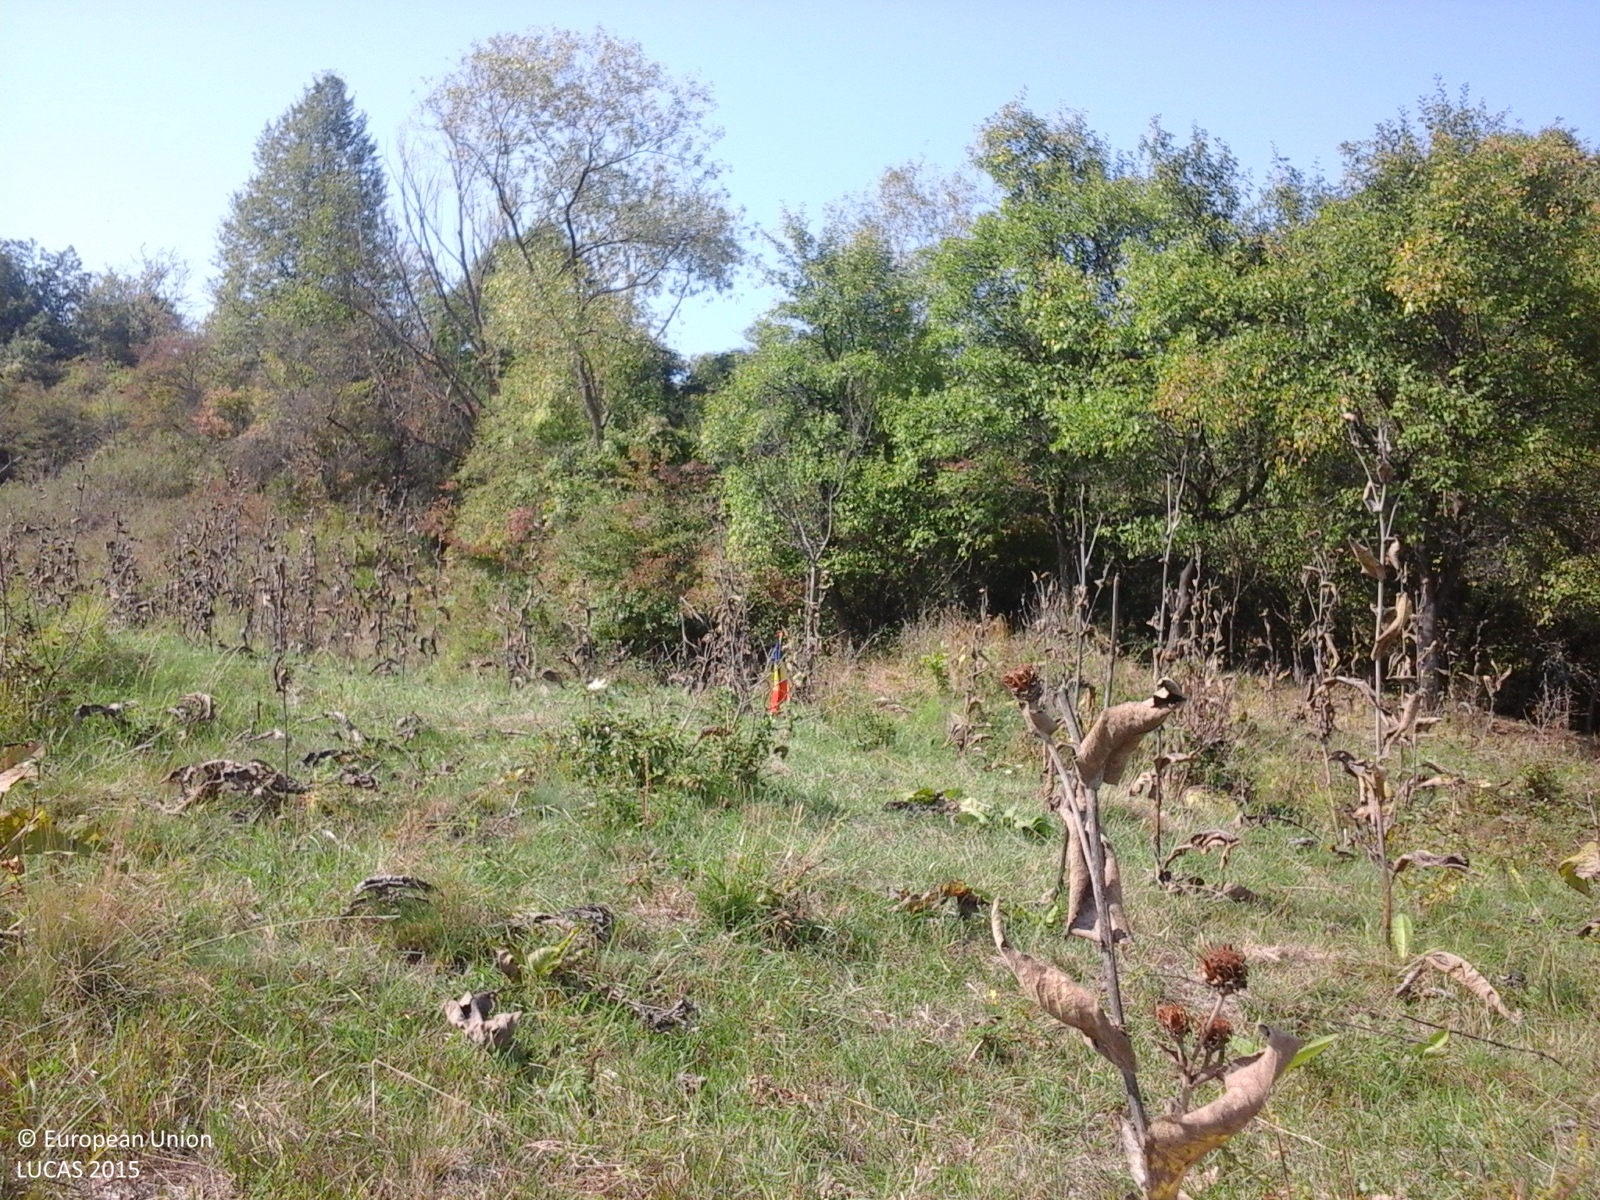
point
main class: Grassland
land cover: Spontaneously vegetated surfaces
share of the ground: > 75 %
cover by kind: herbaceous plants 100 %
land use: Fallow land
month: September
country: RO
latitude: 45.9680
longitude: 22.8947
